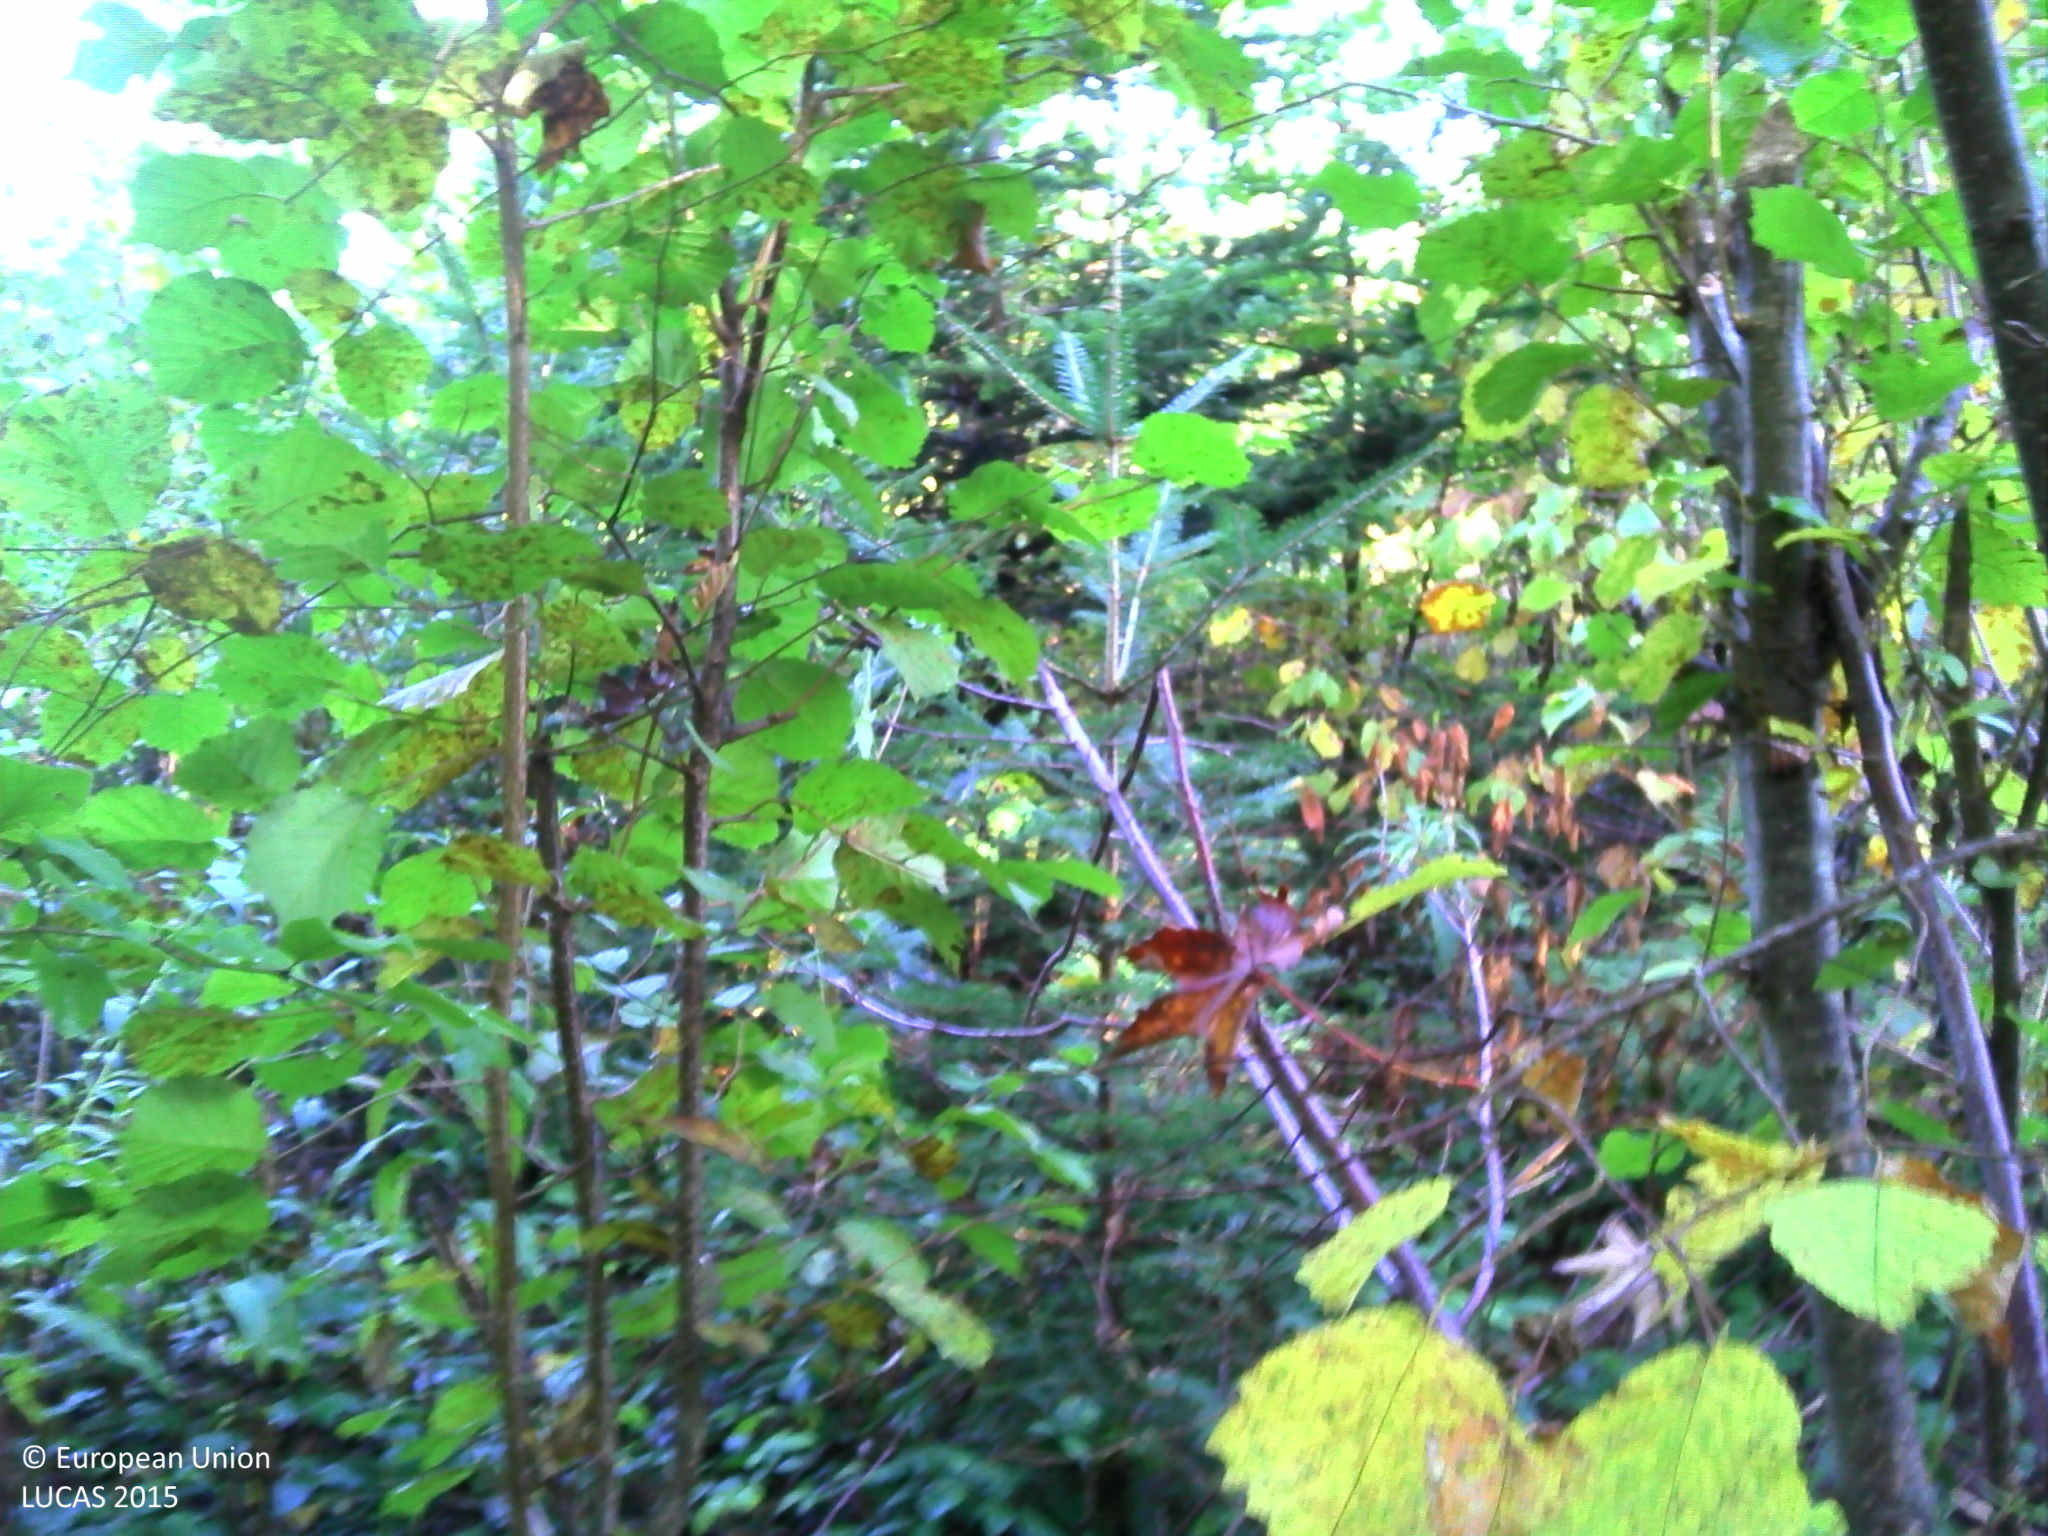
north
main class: Woodland
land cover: Spruce dominated mixed woodland
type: hemiboreal forest and nemoral coniferous forest and mixed broadleaved-coniferous forest
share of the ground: 50 - 75 %
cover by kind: coniferous forest trees 40 %, broadleaved forest trees 30 %, shrubs 20 %, herbaceous plants 10 %
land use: Forestry
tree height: > 5 m
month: October
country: FR
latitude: 47.0813
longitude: 6.3274
